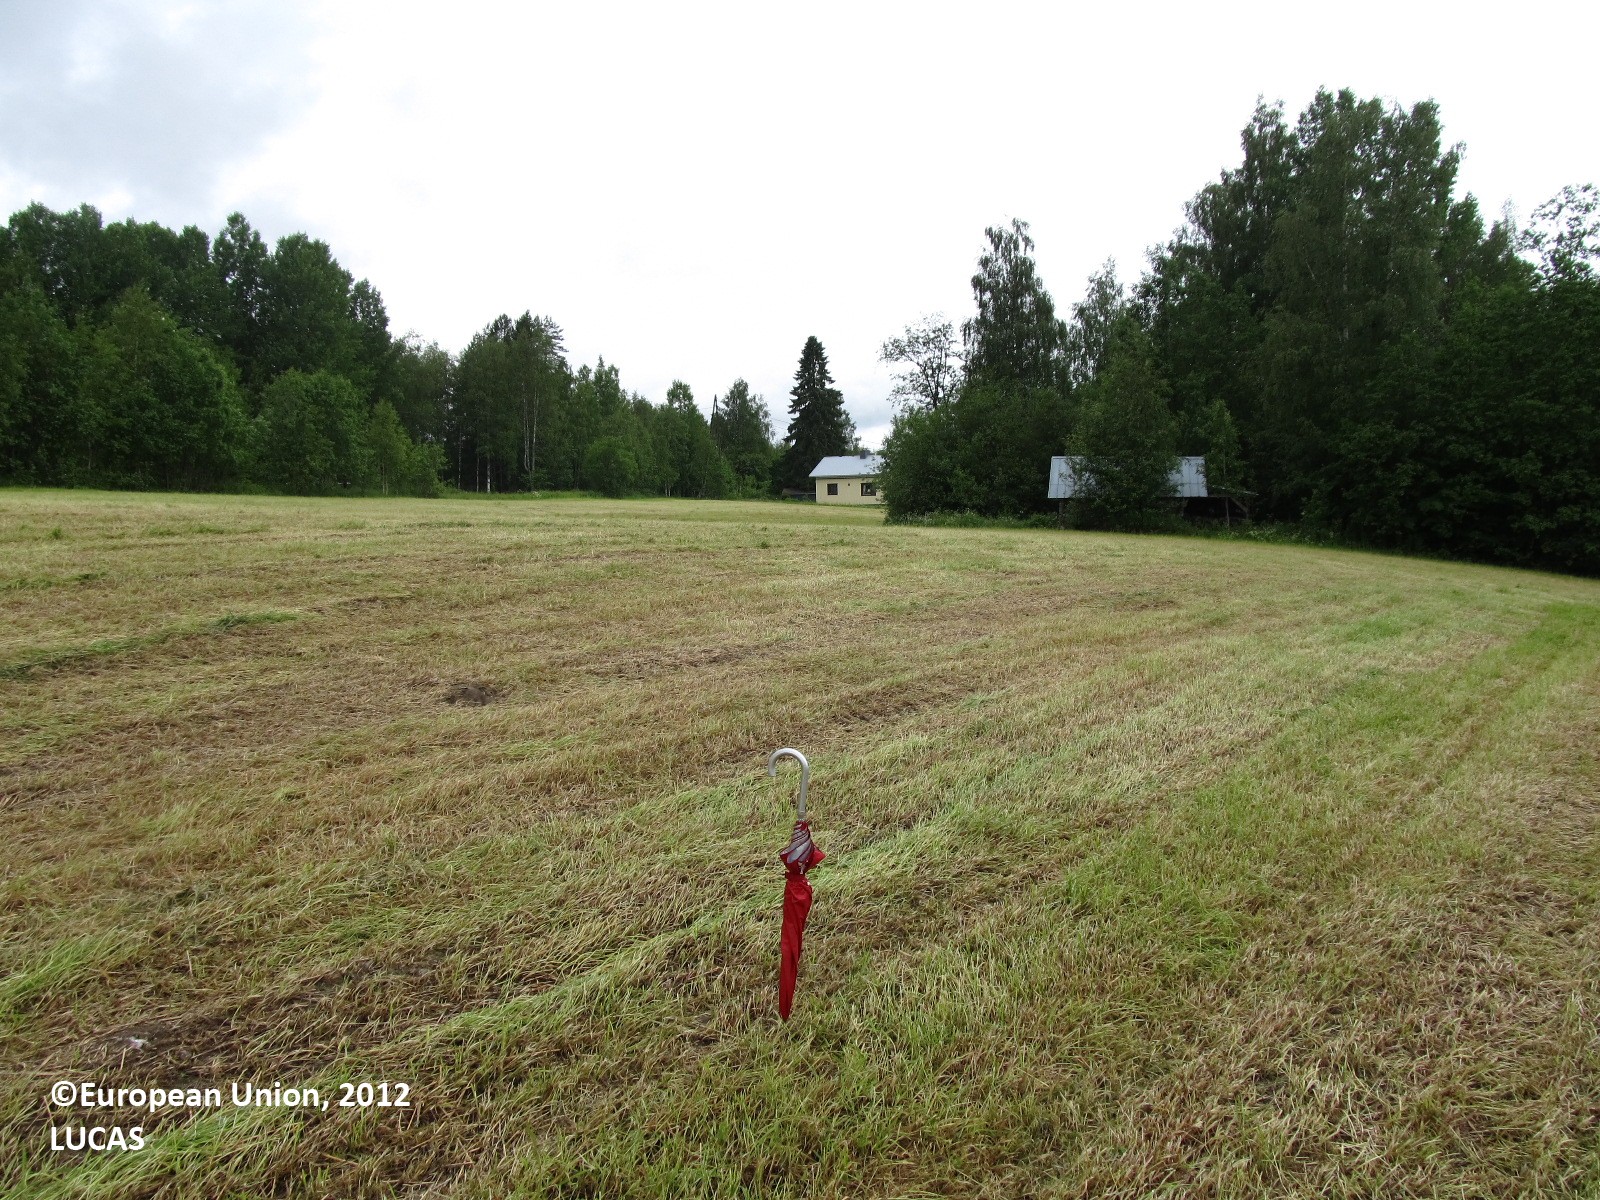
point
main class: Cropland
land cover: Temporary grasslands
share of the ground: > 75 %
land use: Agriculture (excluding fallow land and kitchen gardens)
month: June
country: FI
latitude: 63.1040
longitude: 28.9757
